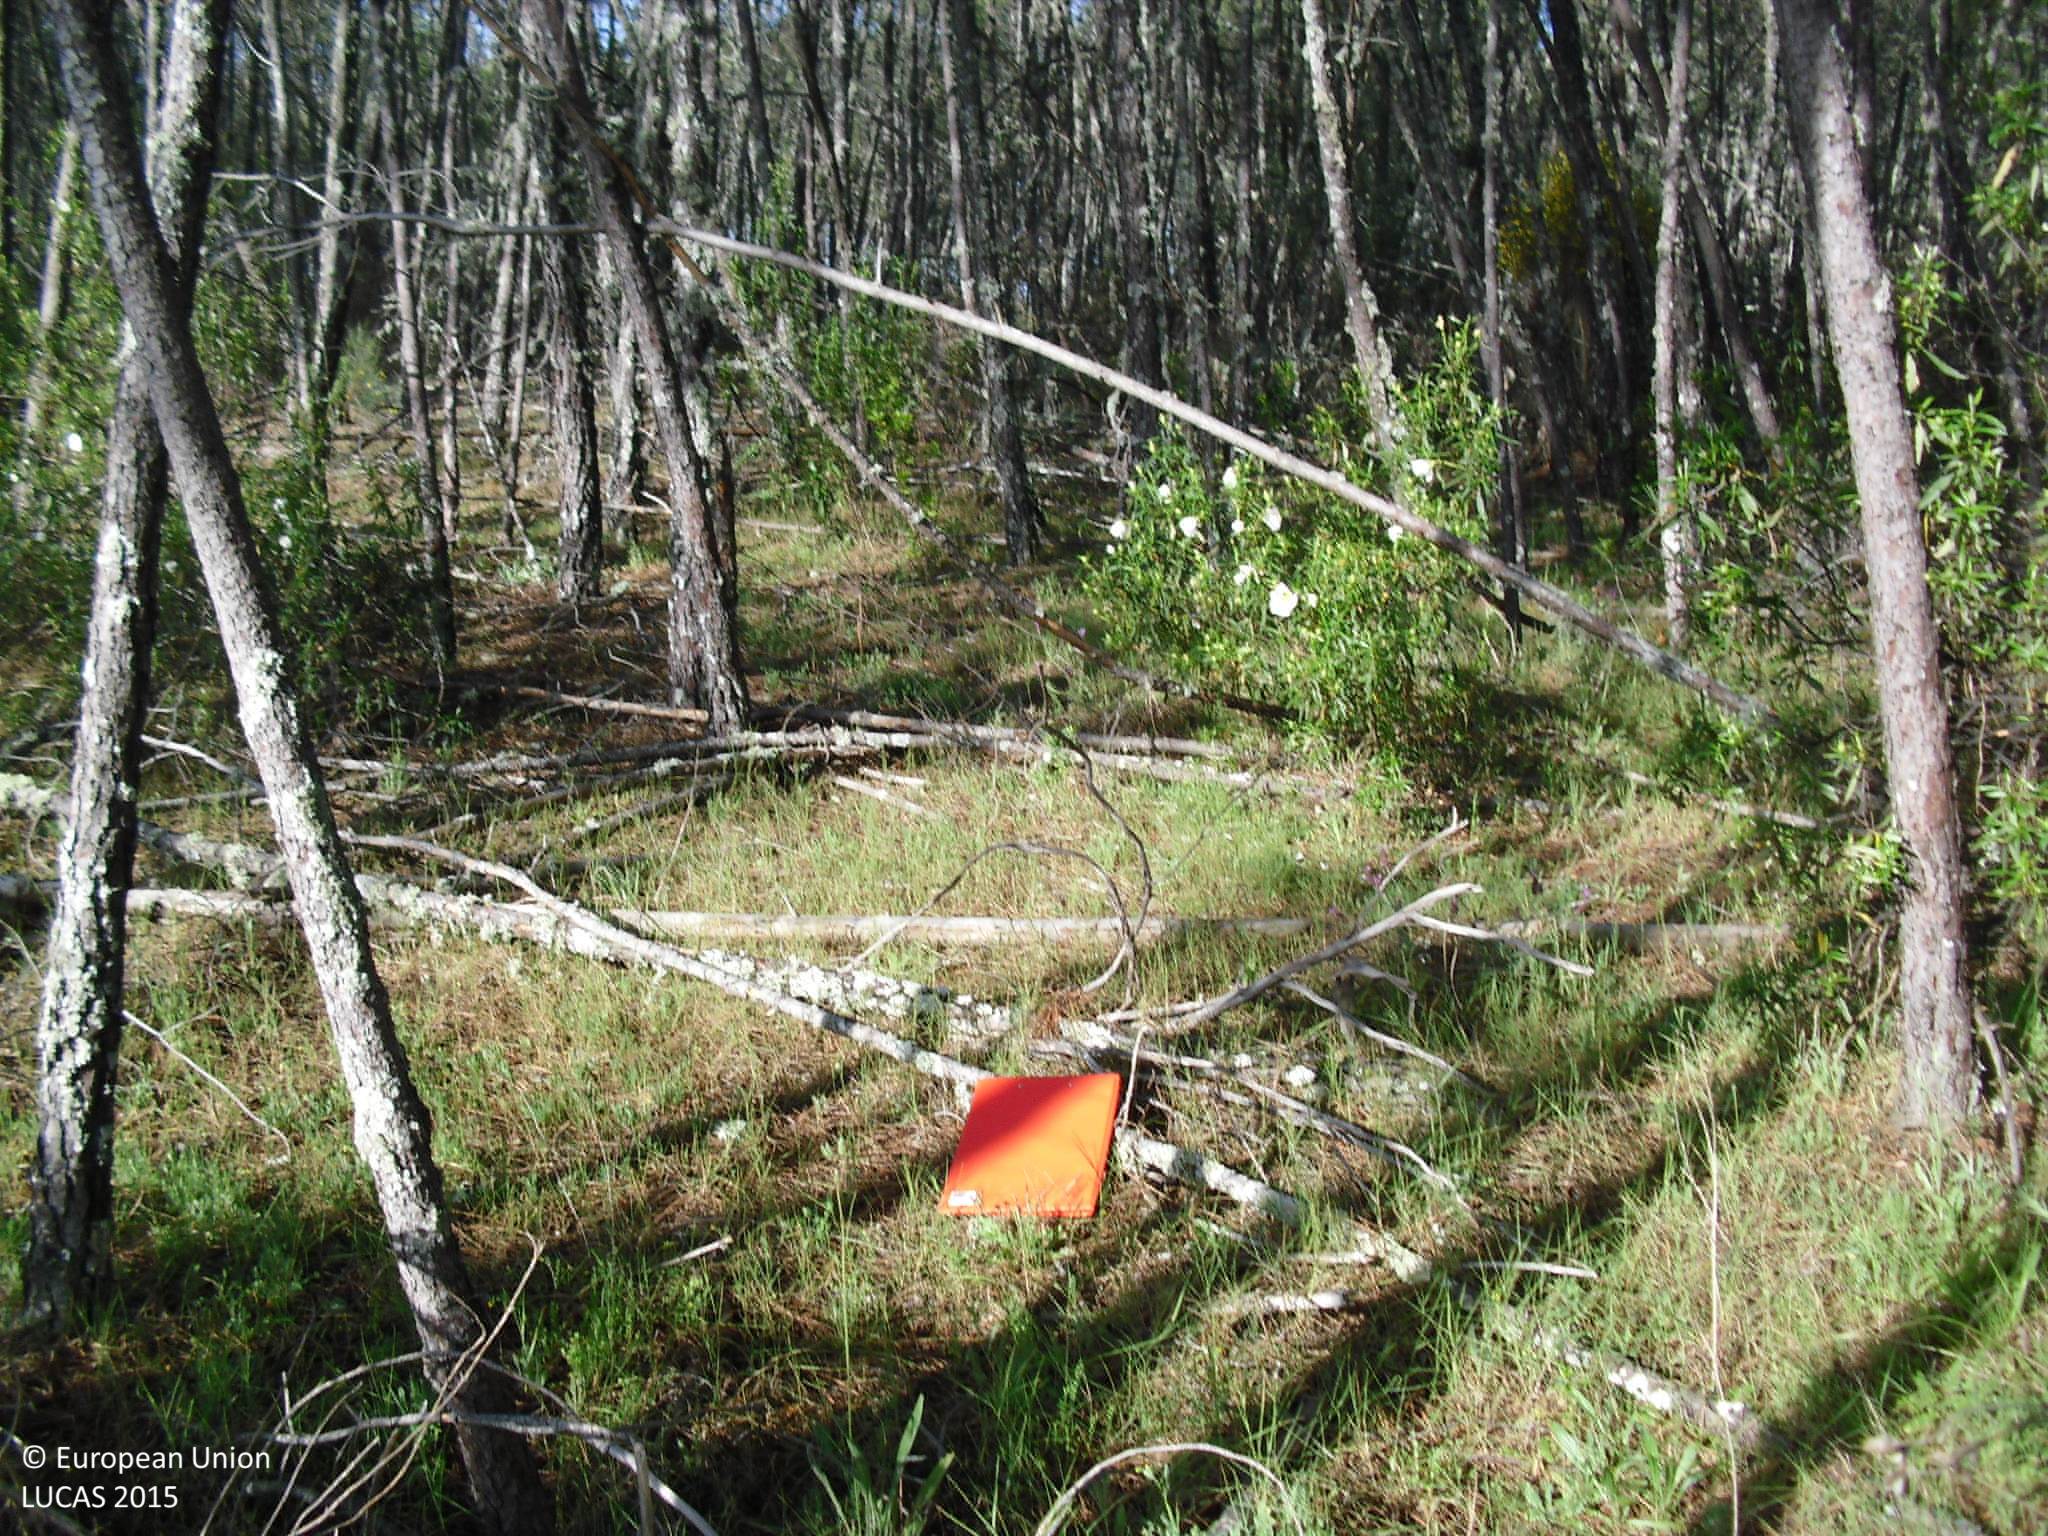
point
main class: Woodland
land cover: Pine dominated coniferous woodland
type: coniferous forest of the mediterranean region
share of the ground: > 75 %
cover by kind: coniferous forest trees 90 %, herbaceous plants 10 %
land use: Forestry
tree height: > 5 m
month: April
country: ES
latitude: 40.0574
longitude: -6.8161
